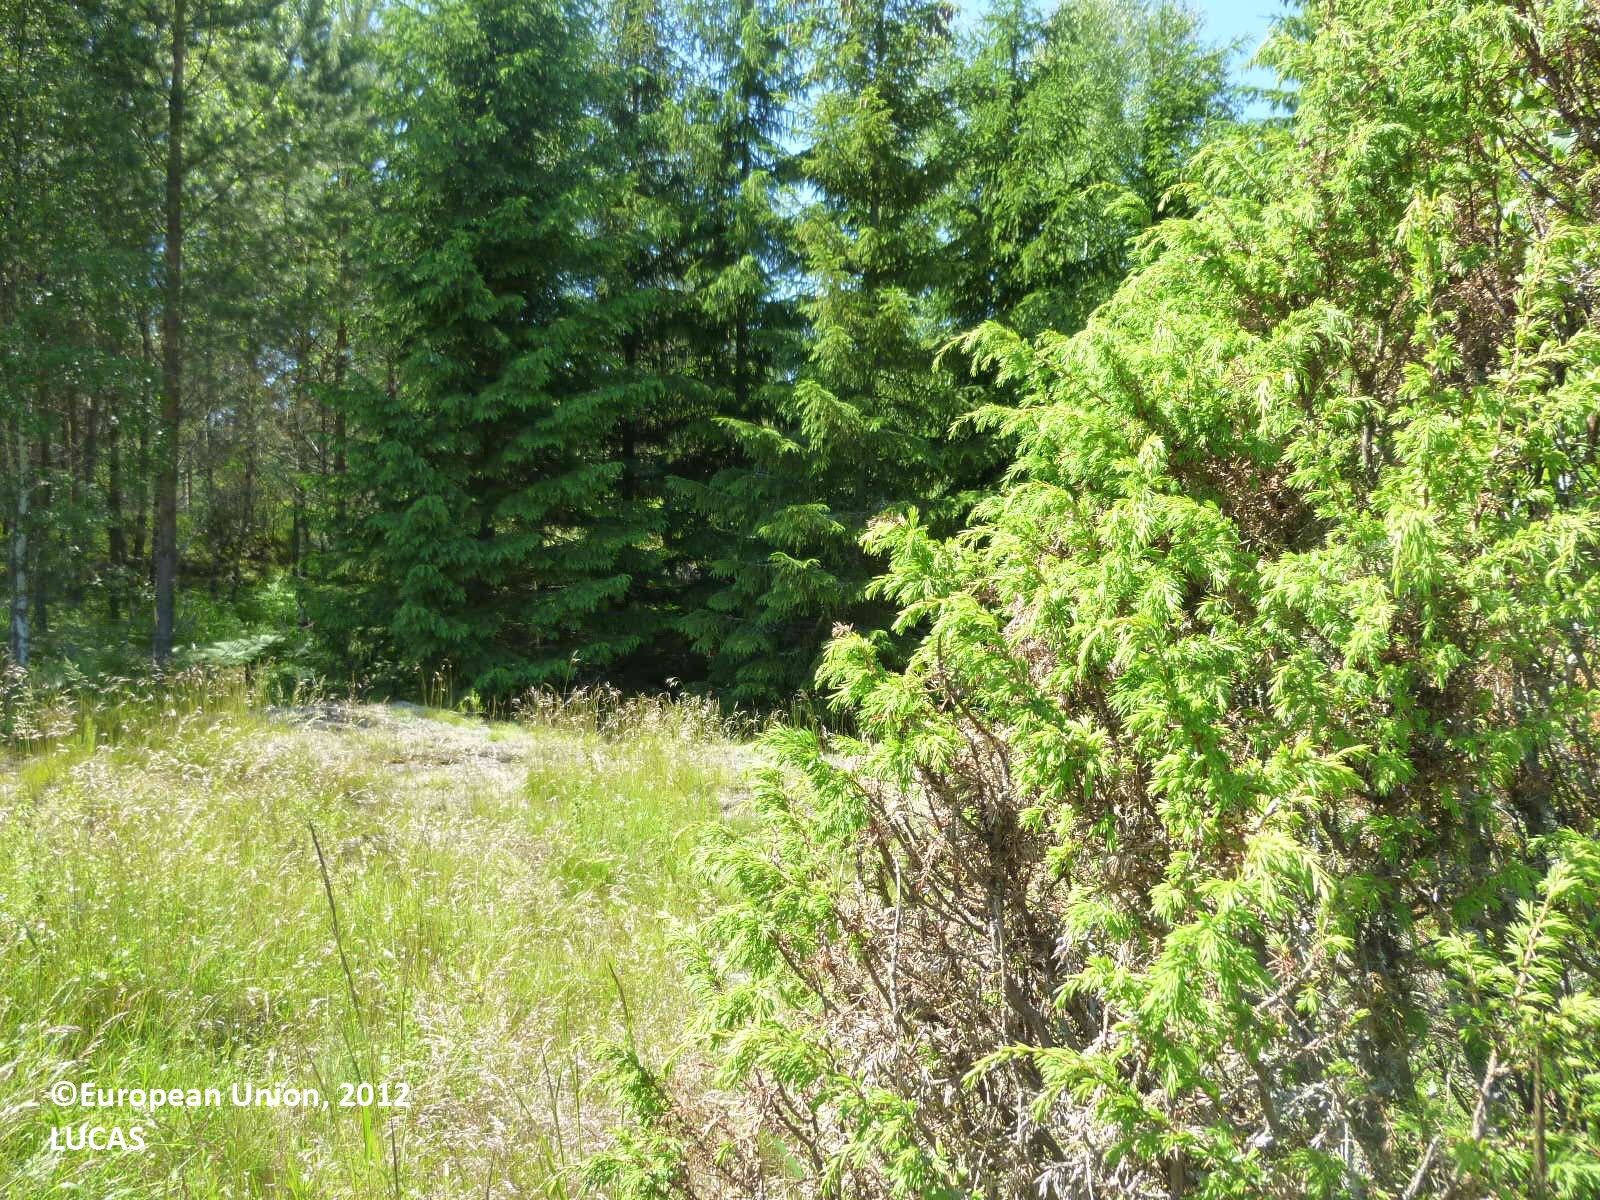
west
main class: Woodland
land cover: Spruce dominated coniferous woodland
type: boreal forest
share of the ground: < 10 %
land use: Forestry
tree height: > 5 m
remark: Clear cut
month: June
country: FI
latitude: 60.1434
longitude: 22.5895
